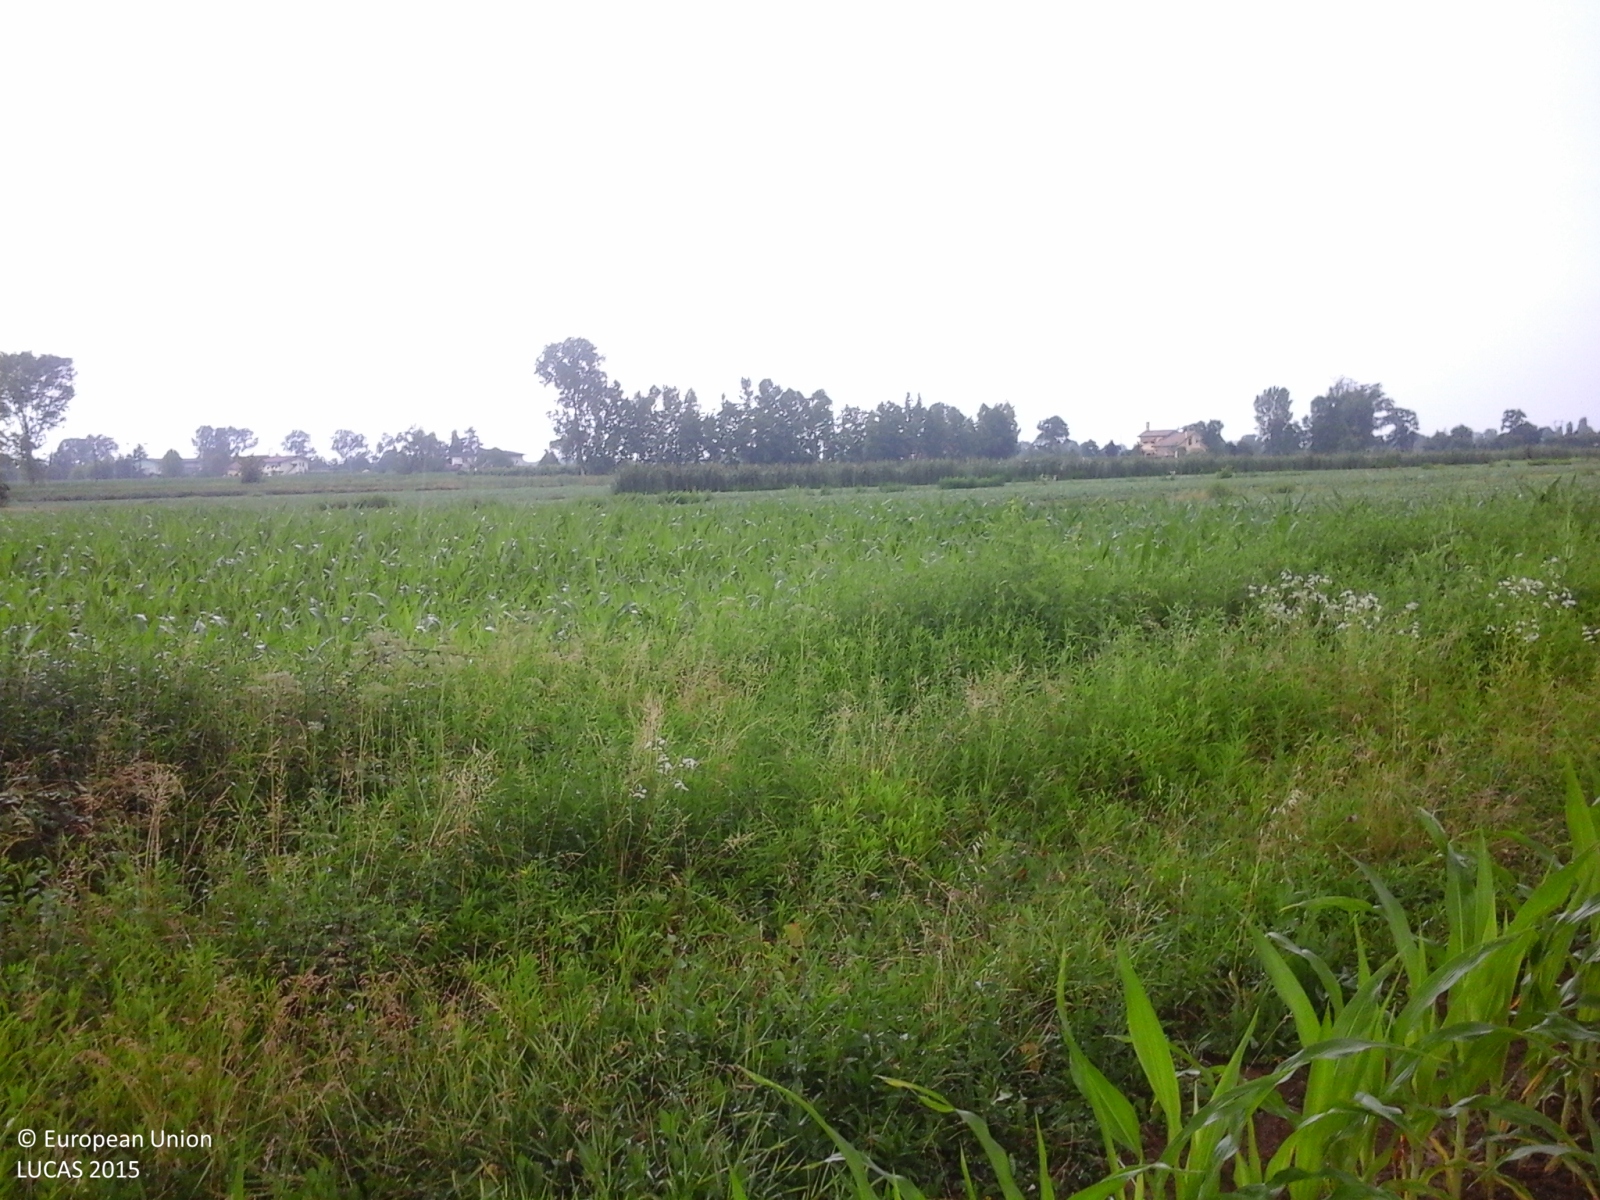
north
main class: Cropland
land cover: Maize
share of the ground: > 75 %
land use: Agriculture (excluding fallow land and kitchen gardens)
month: June
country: IT
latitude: 45.7588
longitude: 12.6834
